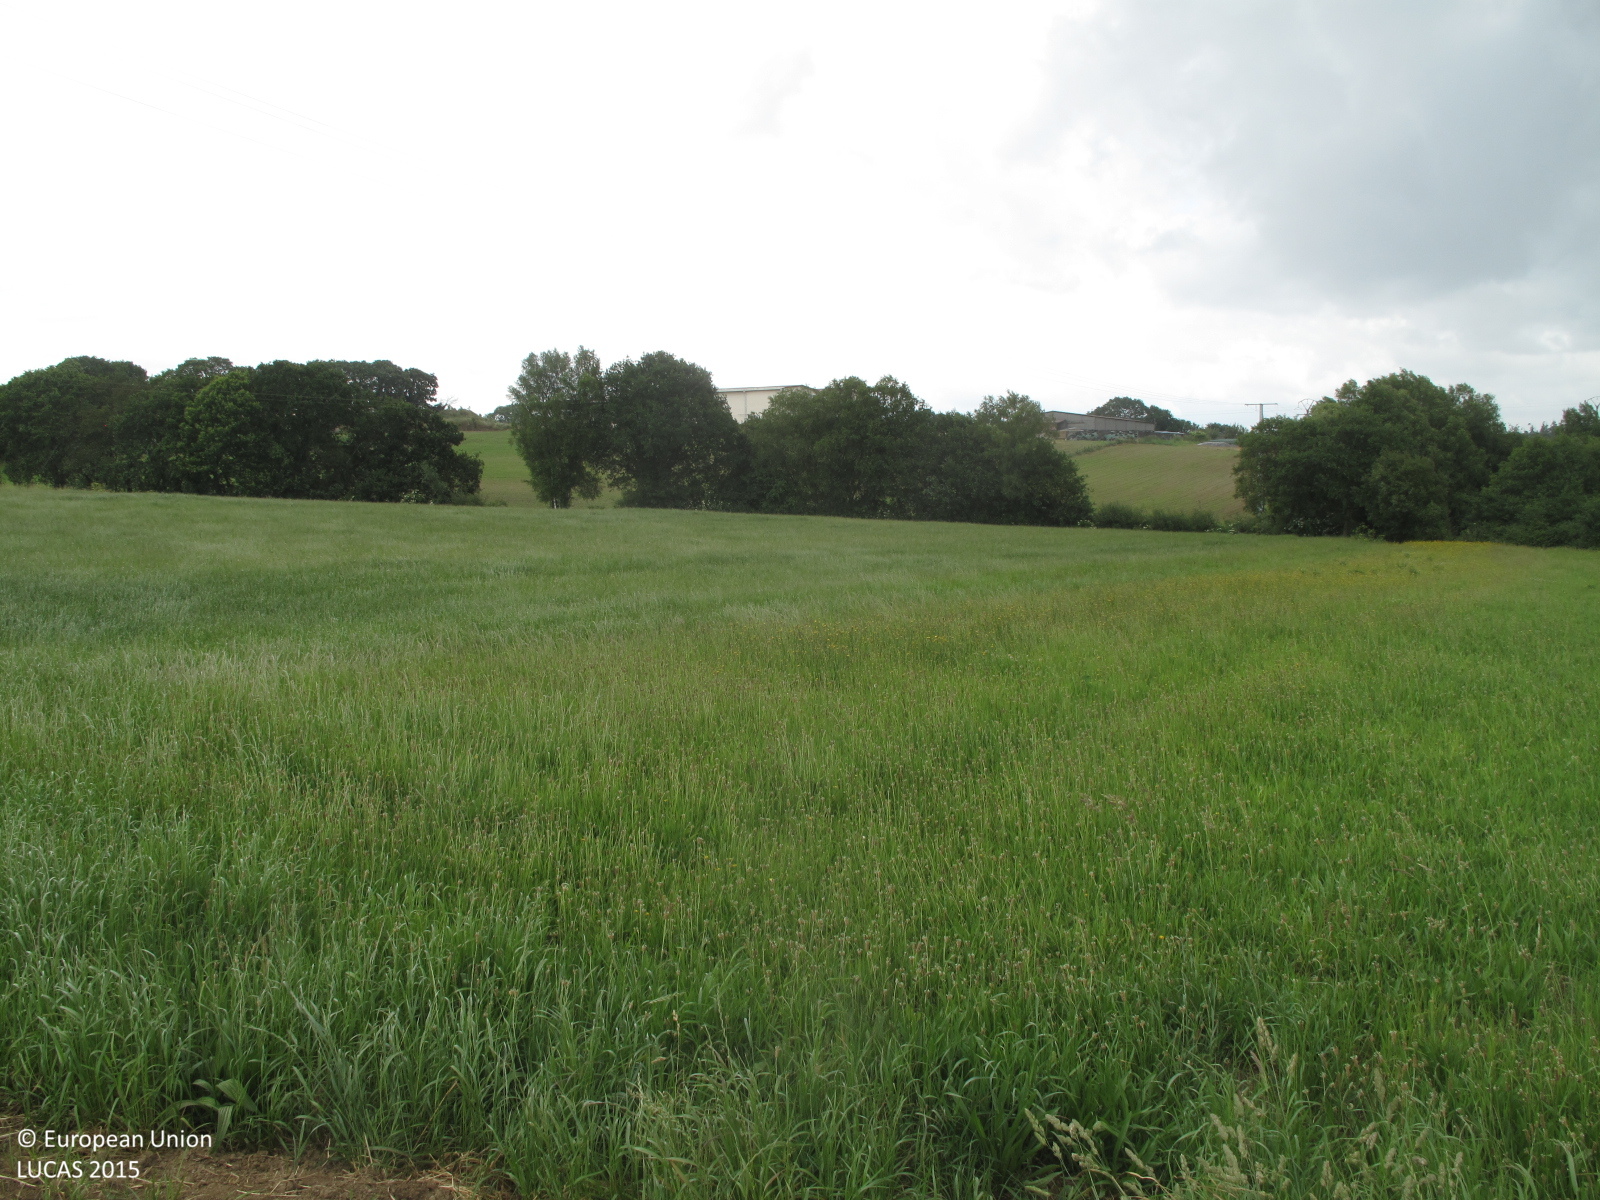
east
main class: Cropland
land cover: Maize
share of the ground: < 10 %
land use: Agriculture (excluding fallow land and kitchen gardens)
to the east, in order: Maize; Grassland without tree/shrub cover; Electric lines; Grassland without tree/shrub cover; Broadleaved woodland; Shrubland with sparse tree cover; Rivers and streams; Maize; Other bare soil
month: June
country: ES
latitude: 43.0725
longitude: -8.5160
